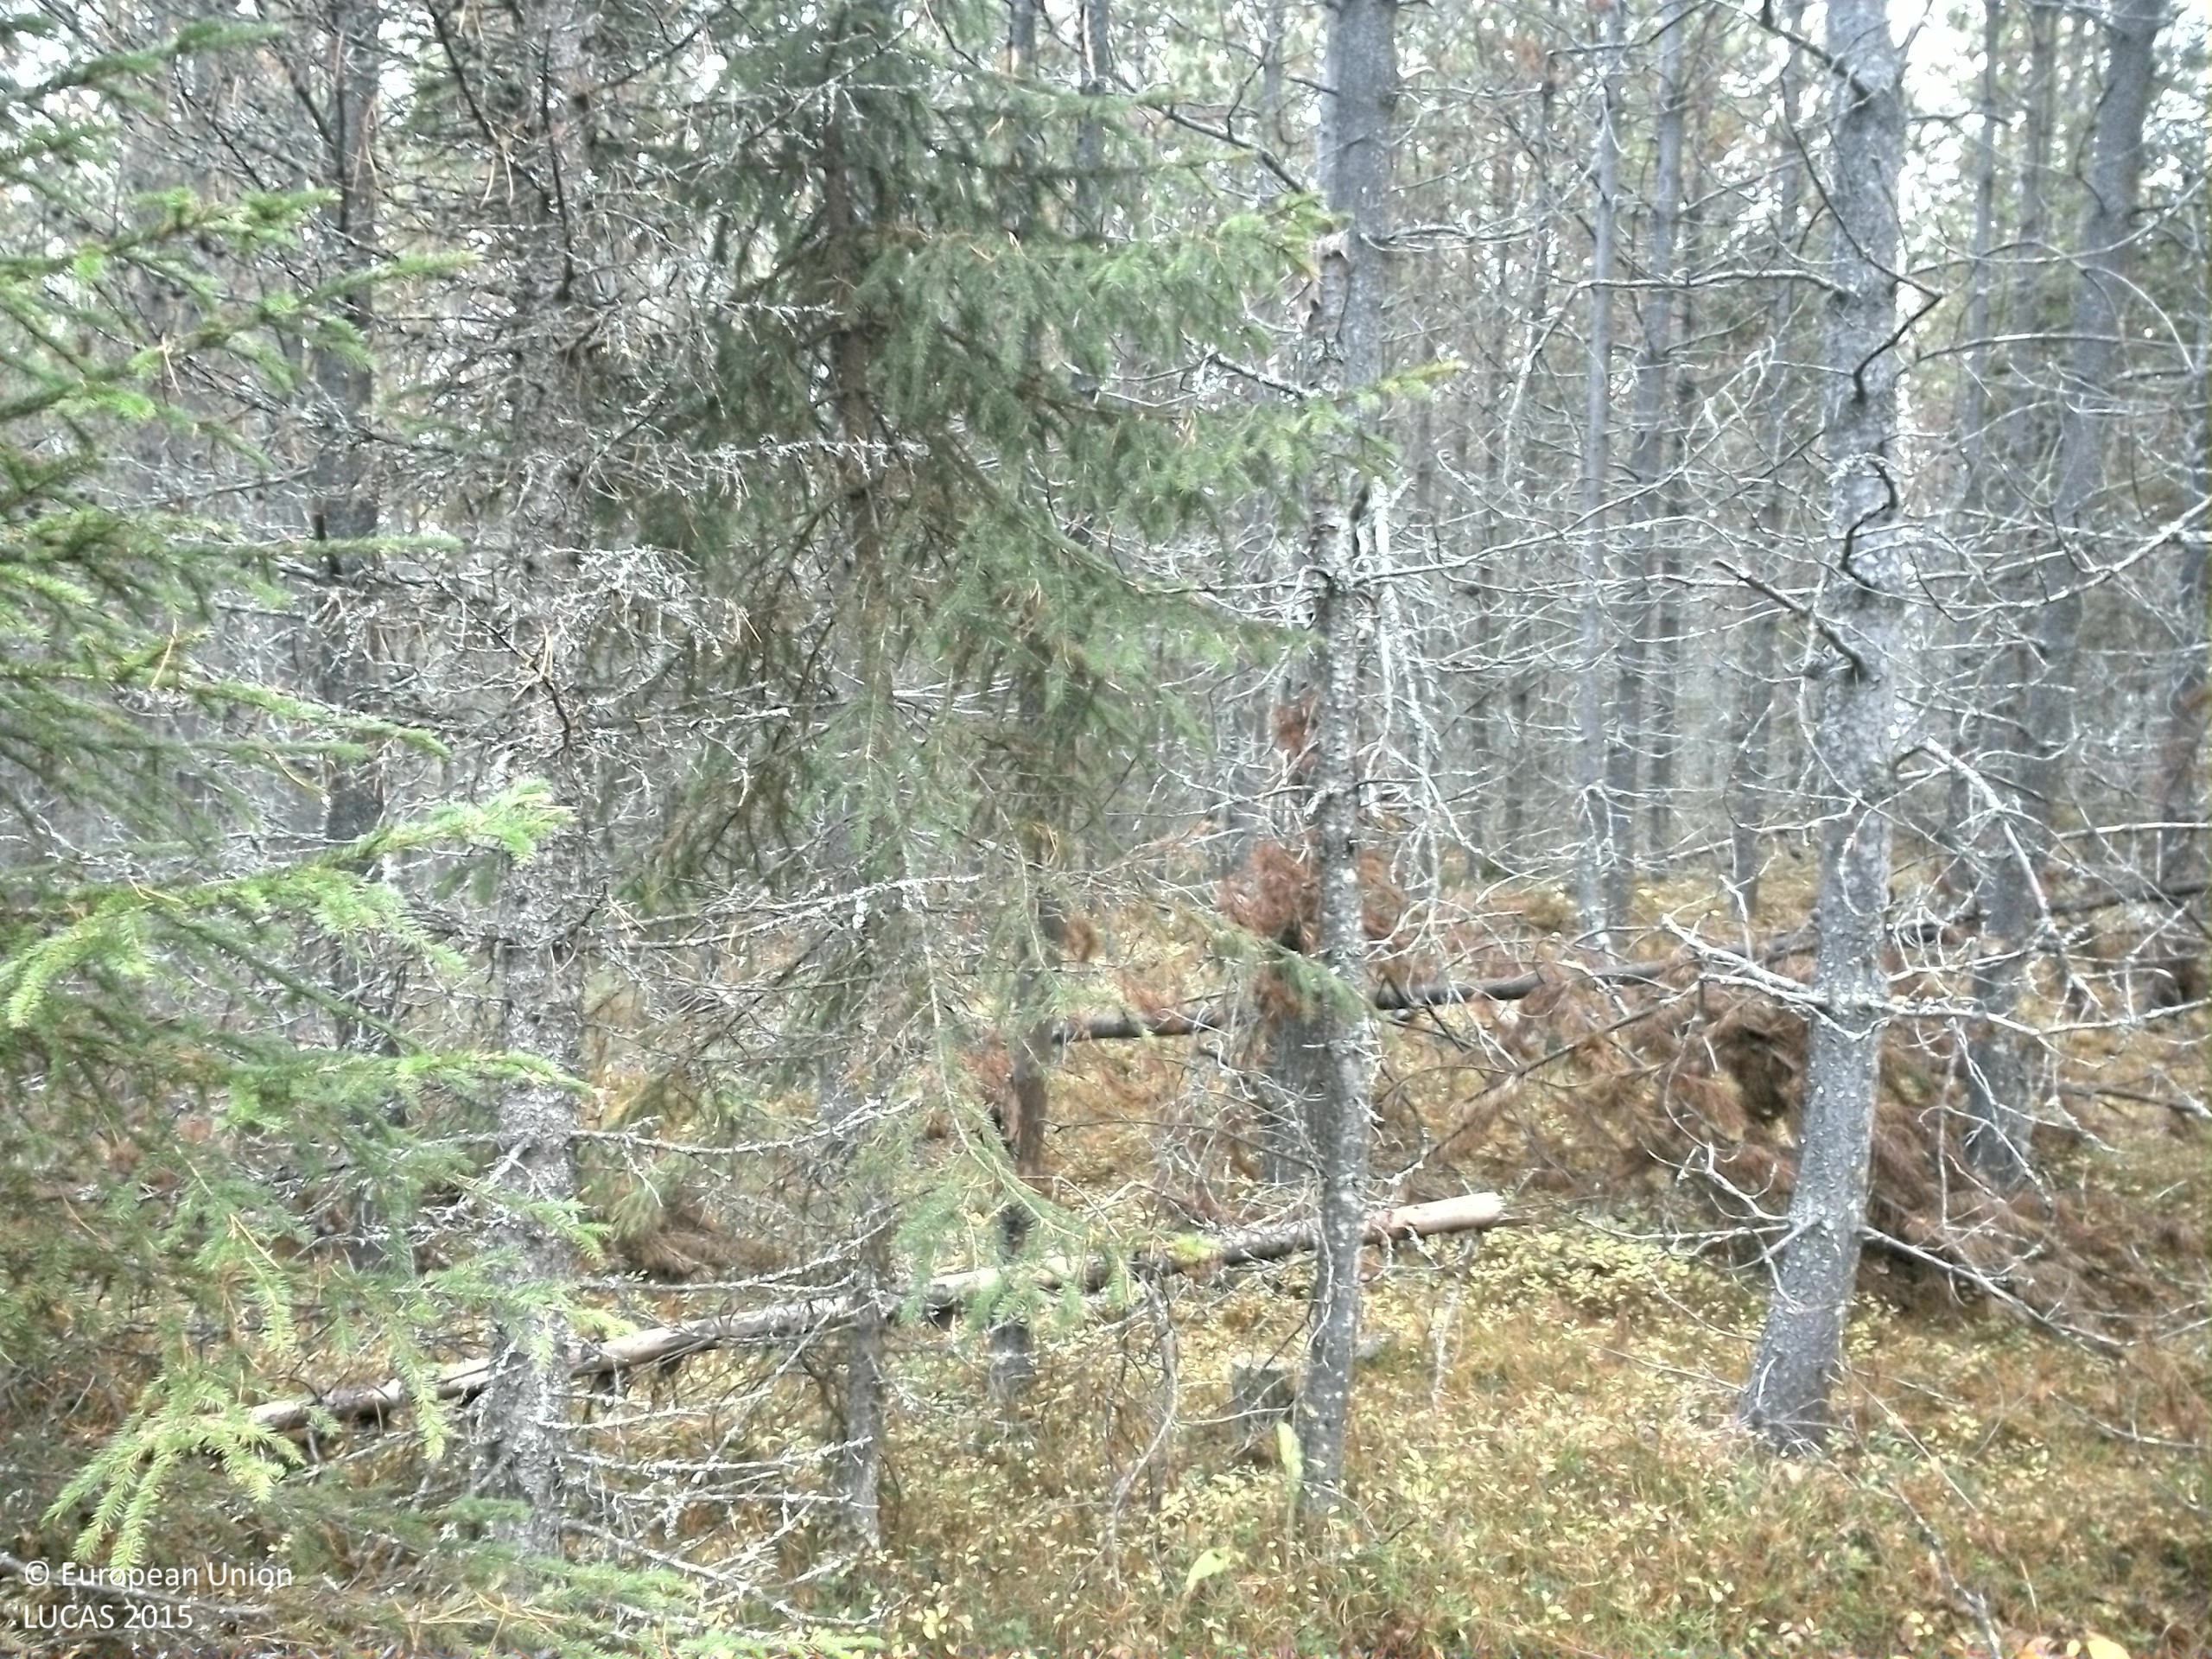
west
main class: Woodland
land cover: Pine dominated coniferous woodland
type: exotic forest
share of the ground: 25 - 50 %
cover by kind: coniferous forest trees 45 %, shrubs 35 %, lichens and mosses 15 %, unconsolidated bare surface 5 %
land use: Forestry
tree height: > 5 m
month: October
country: SE
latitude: 64.3046
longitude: 15.4491
